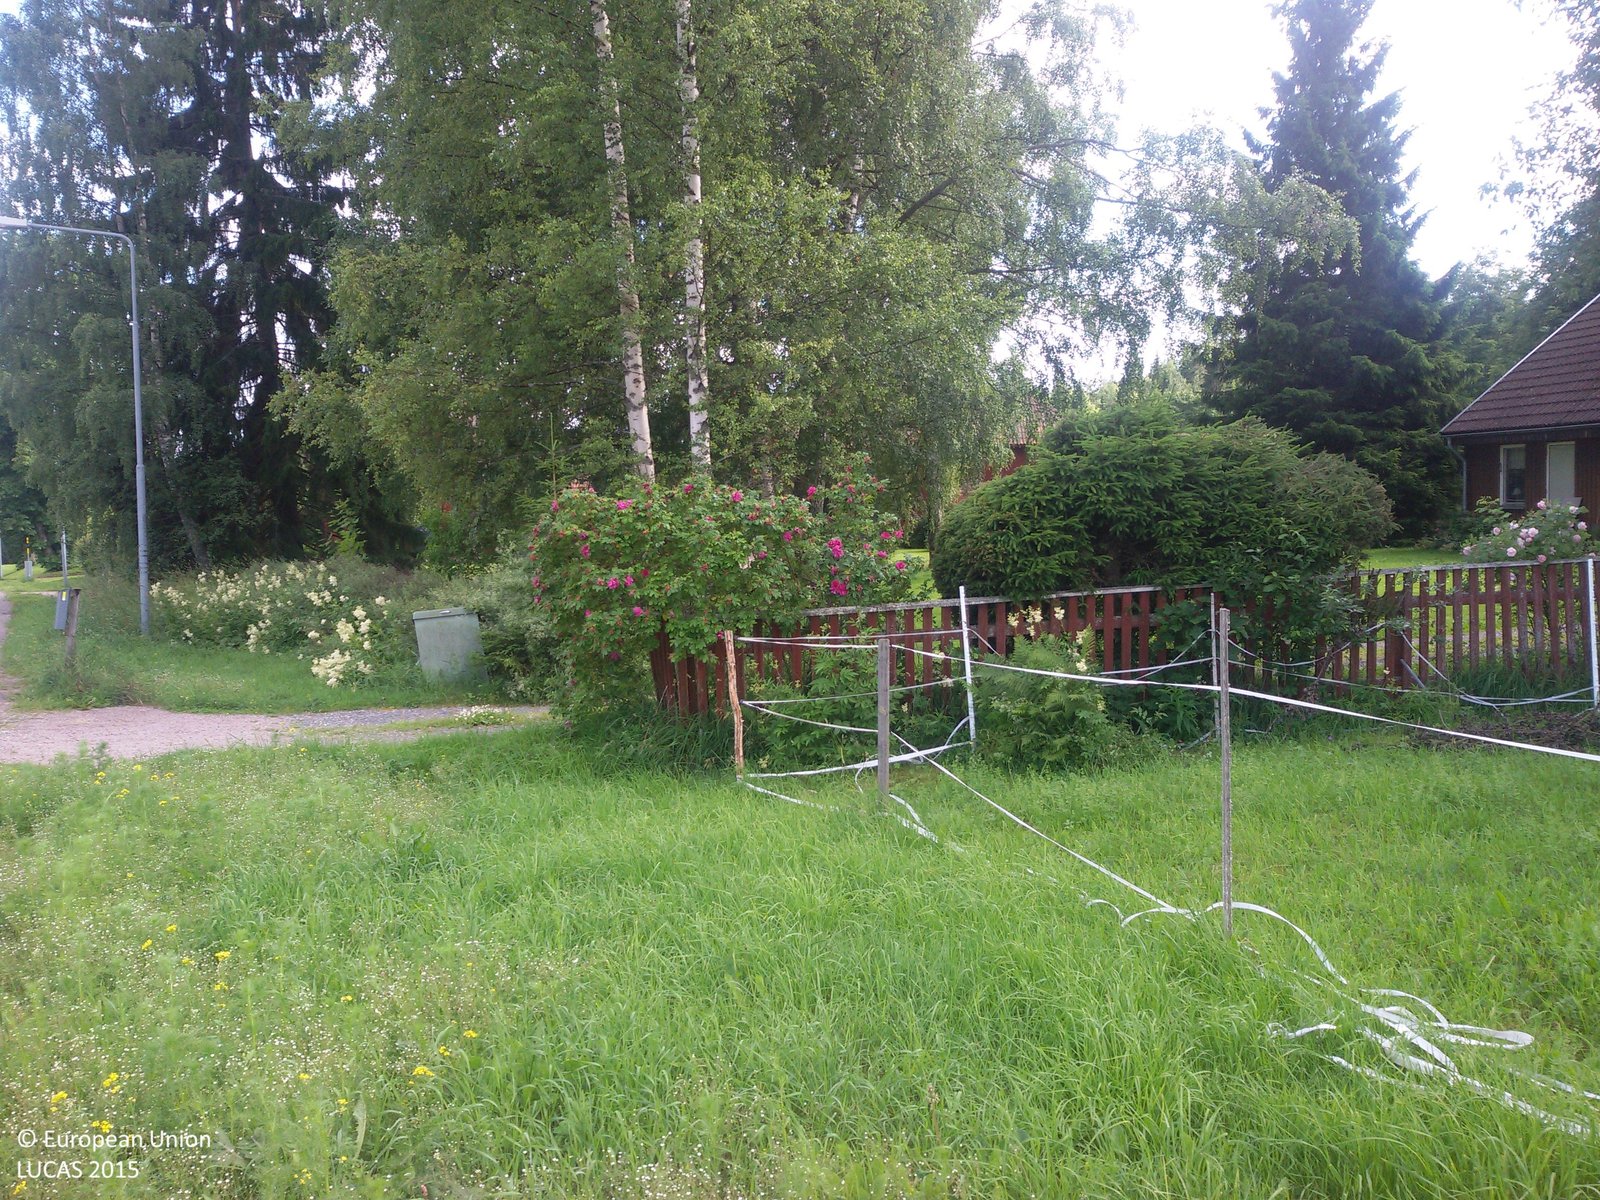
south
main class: Grassland
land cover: Grassland without tree/shrub cover
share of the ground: > 75 %
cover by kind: herbaceous plants 100 %
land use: Road transport
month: July
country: SE
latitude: 60.4748
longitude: 15.3906
